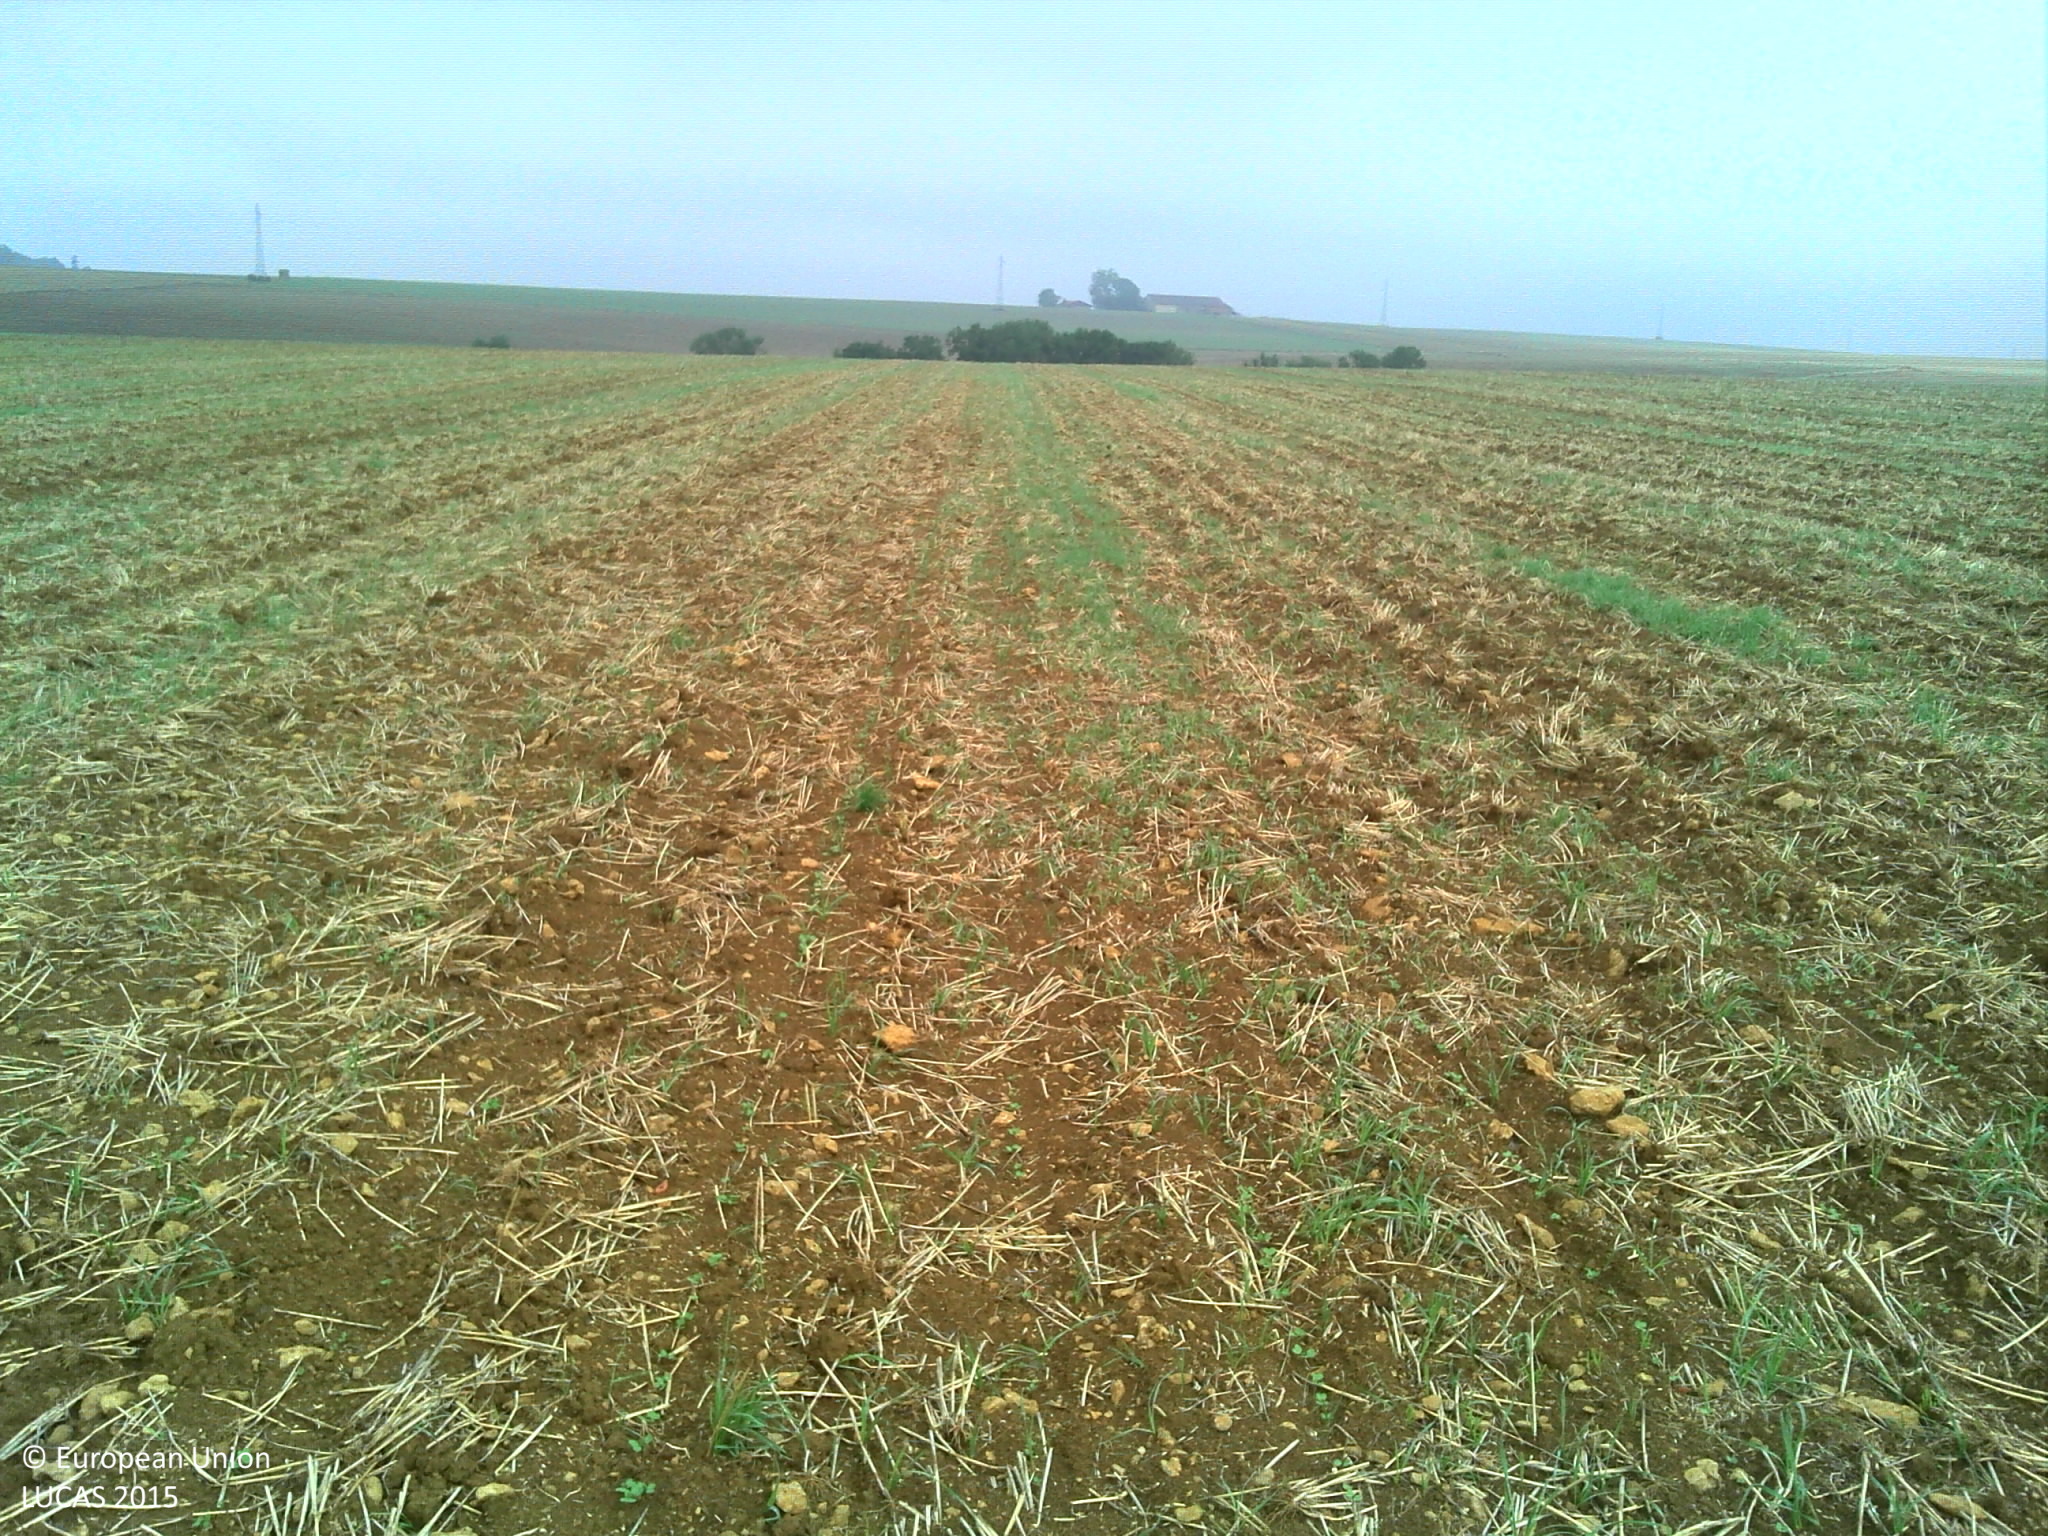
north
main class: Cropland
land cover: Other fibre and oleaginous crops
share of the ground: < 10 %
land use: Agriculture (excluding fallow land and kitchen gardens)
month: September
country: FR
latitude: 49.1751
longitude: 5.9254
